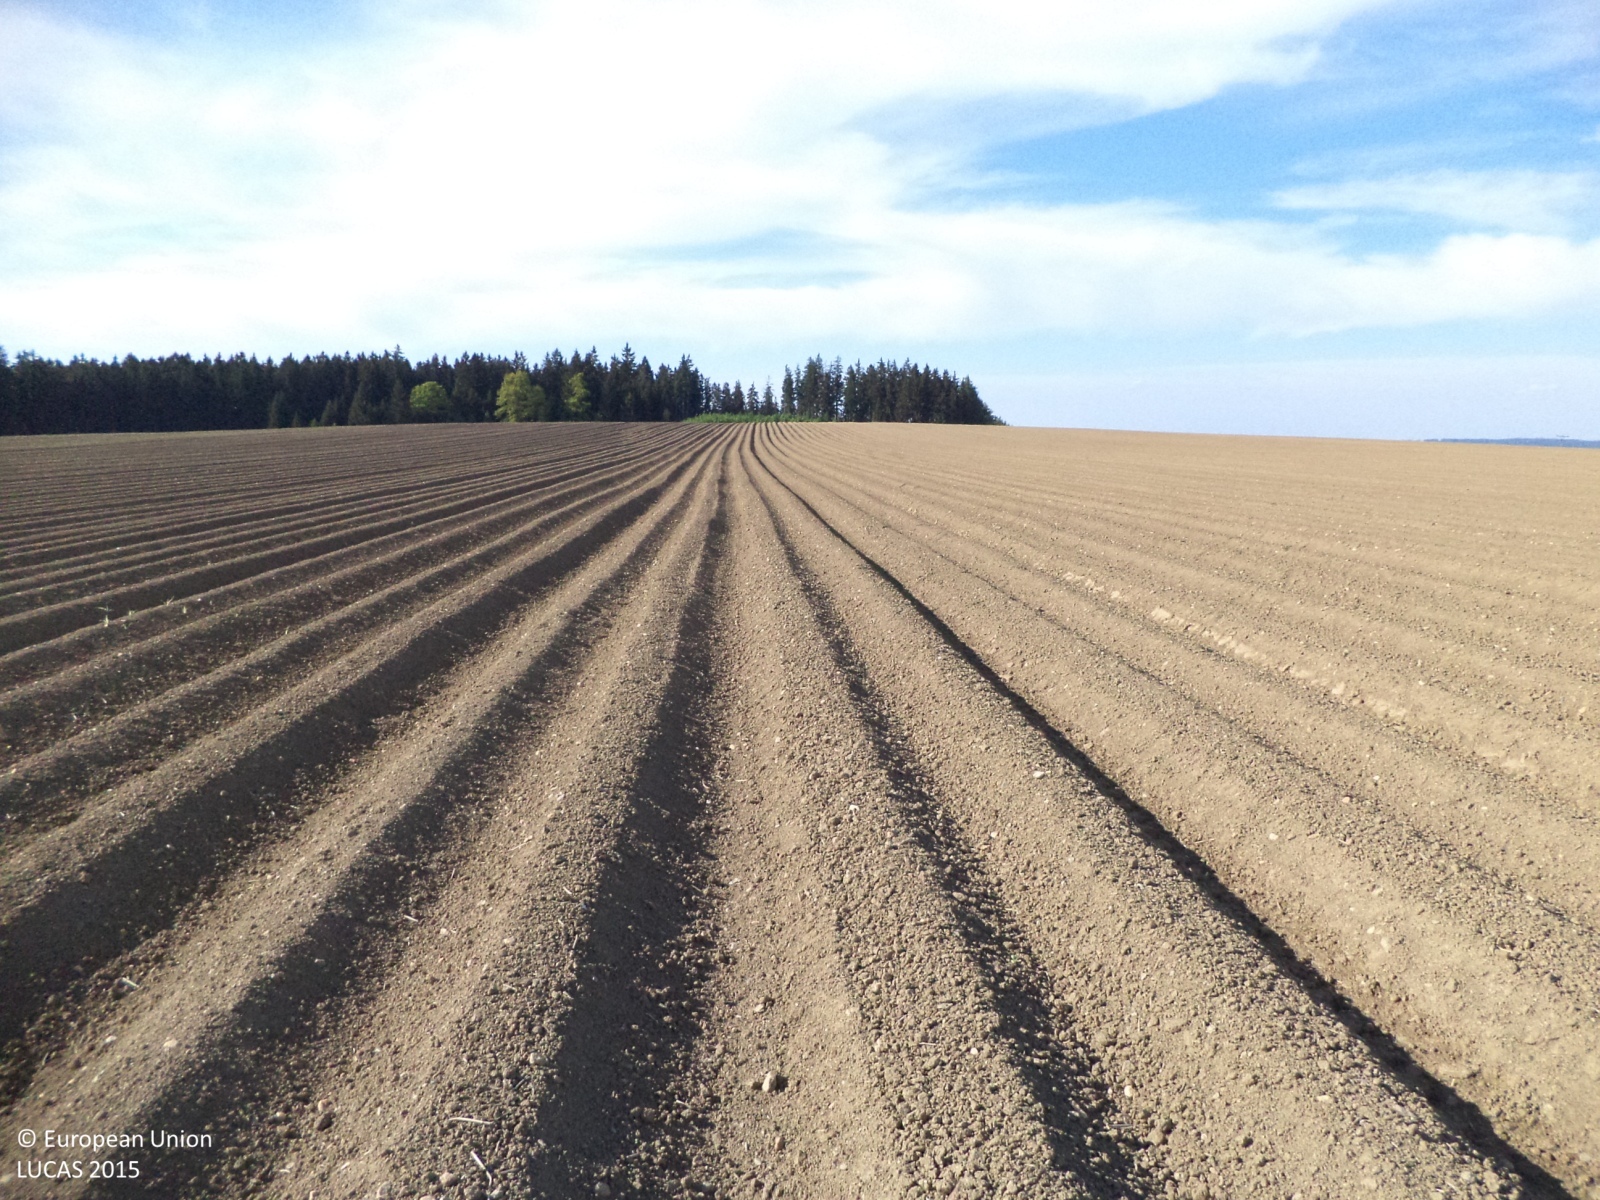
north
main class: Cropland
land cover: Potatoes
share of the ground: < 10 %
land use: Agriculture (excluding fallow land and kitchen gardens)
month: May
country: CZ
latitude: 49.4578
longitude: 15.0934
